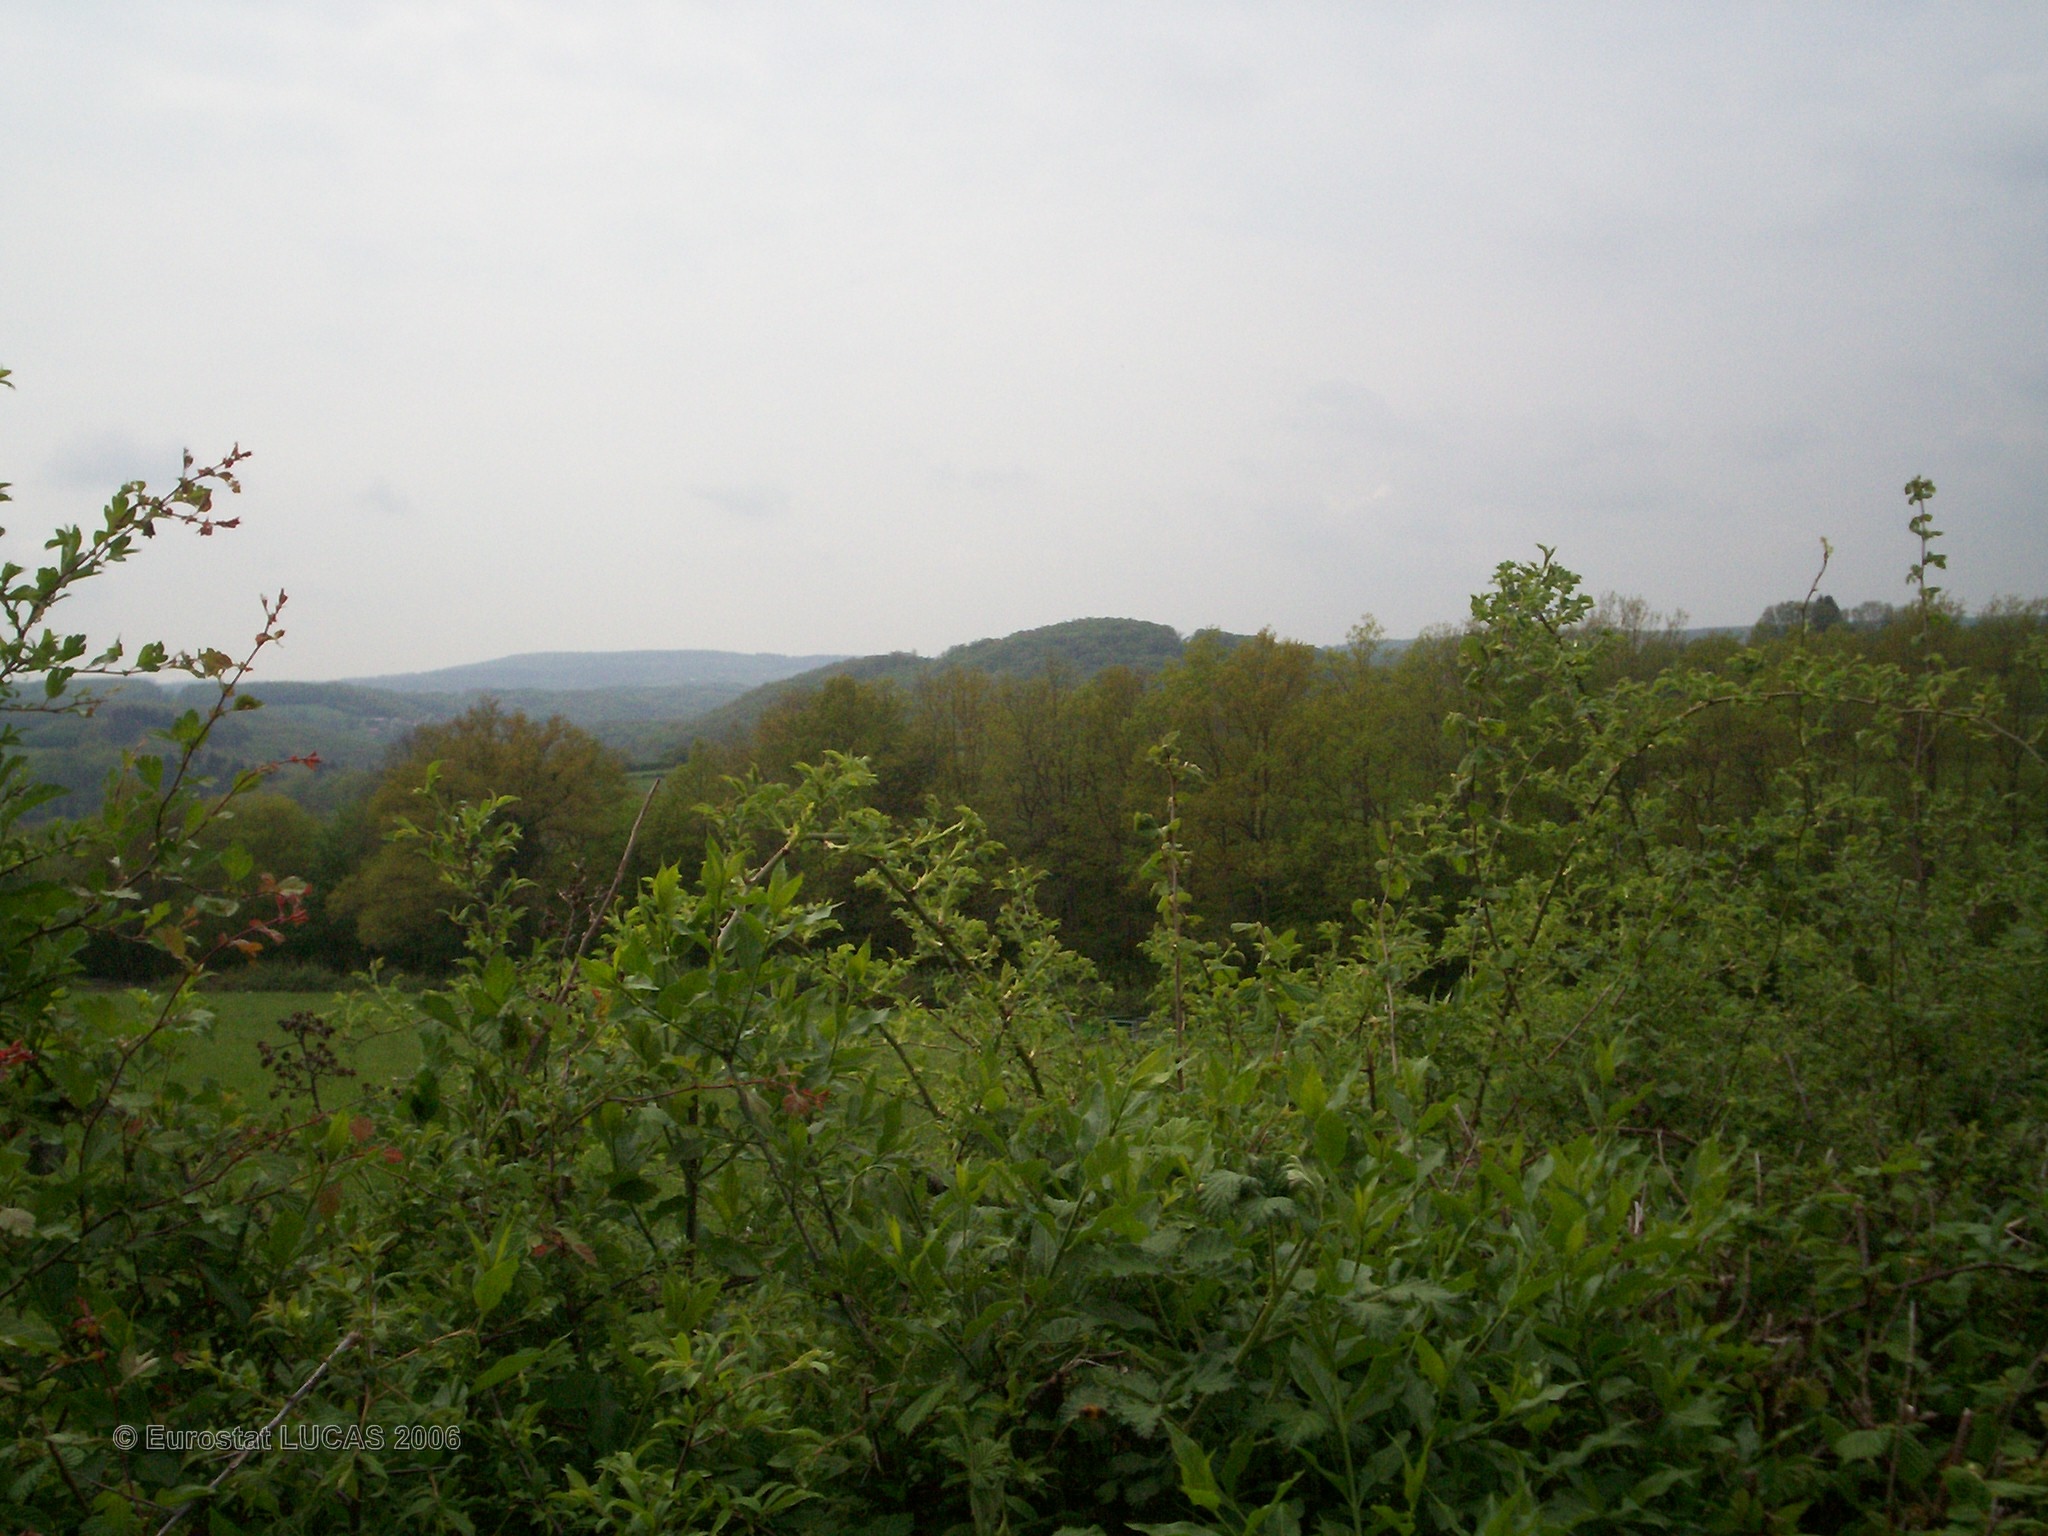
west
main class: Grassland
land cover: Grassland without tree/shrub cover
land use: Agriculture (excluding fallow land and kitchen gardens)
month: May
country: FR
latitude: 47.4043
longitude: 3.8889
